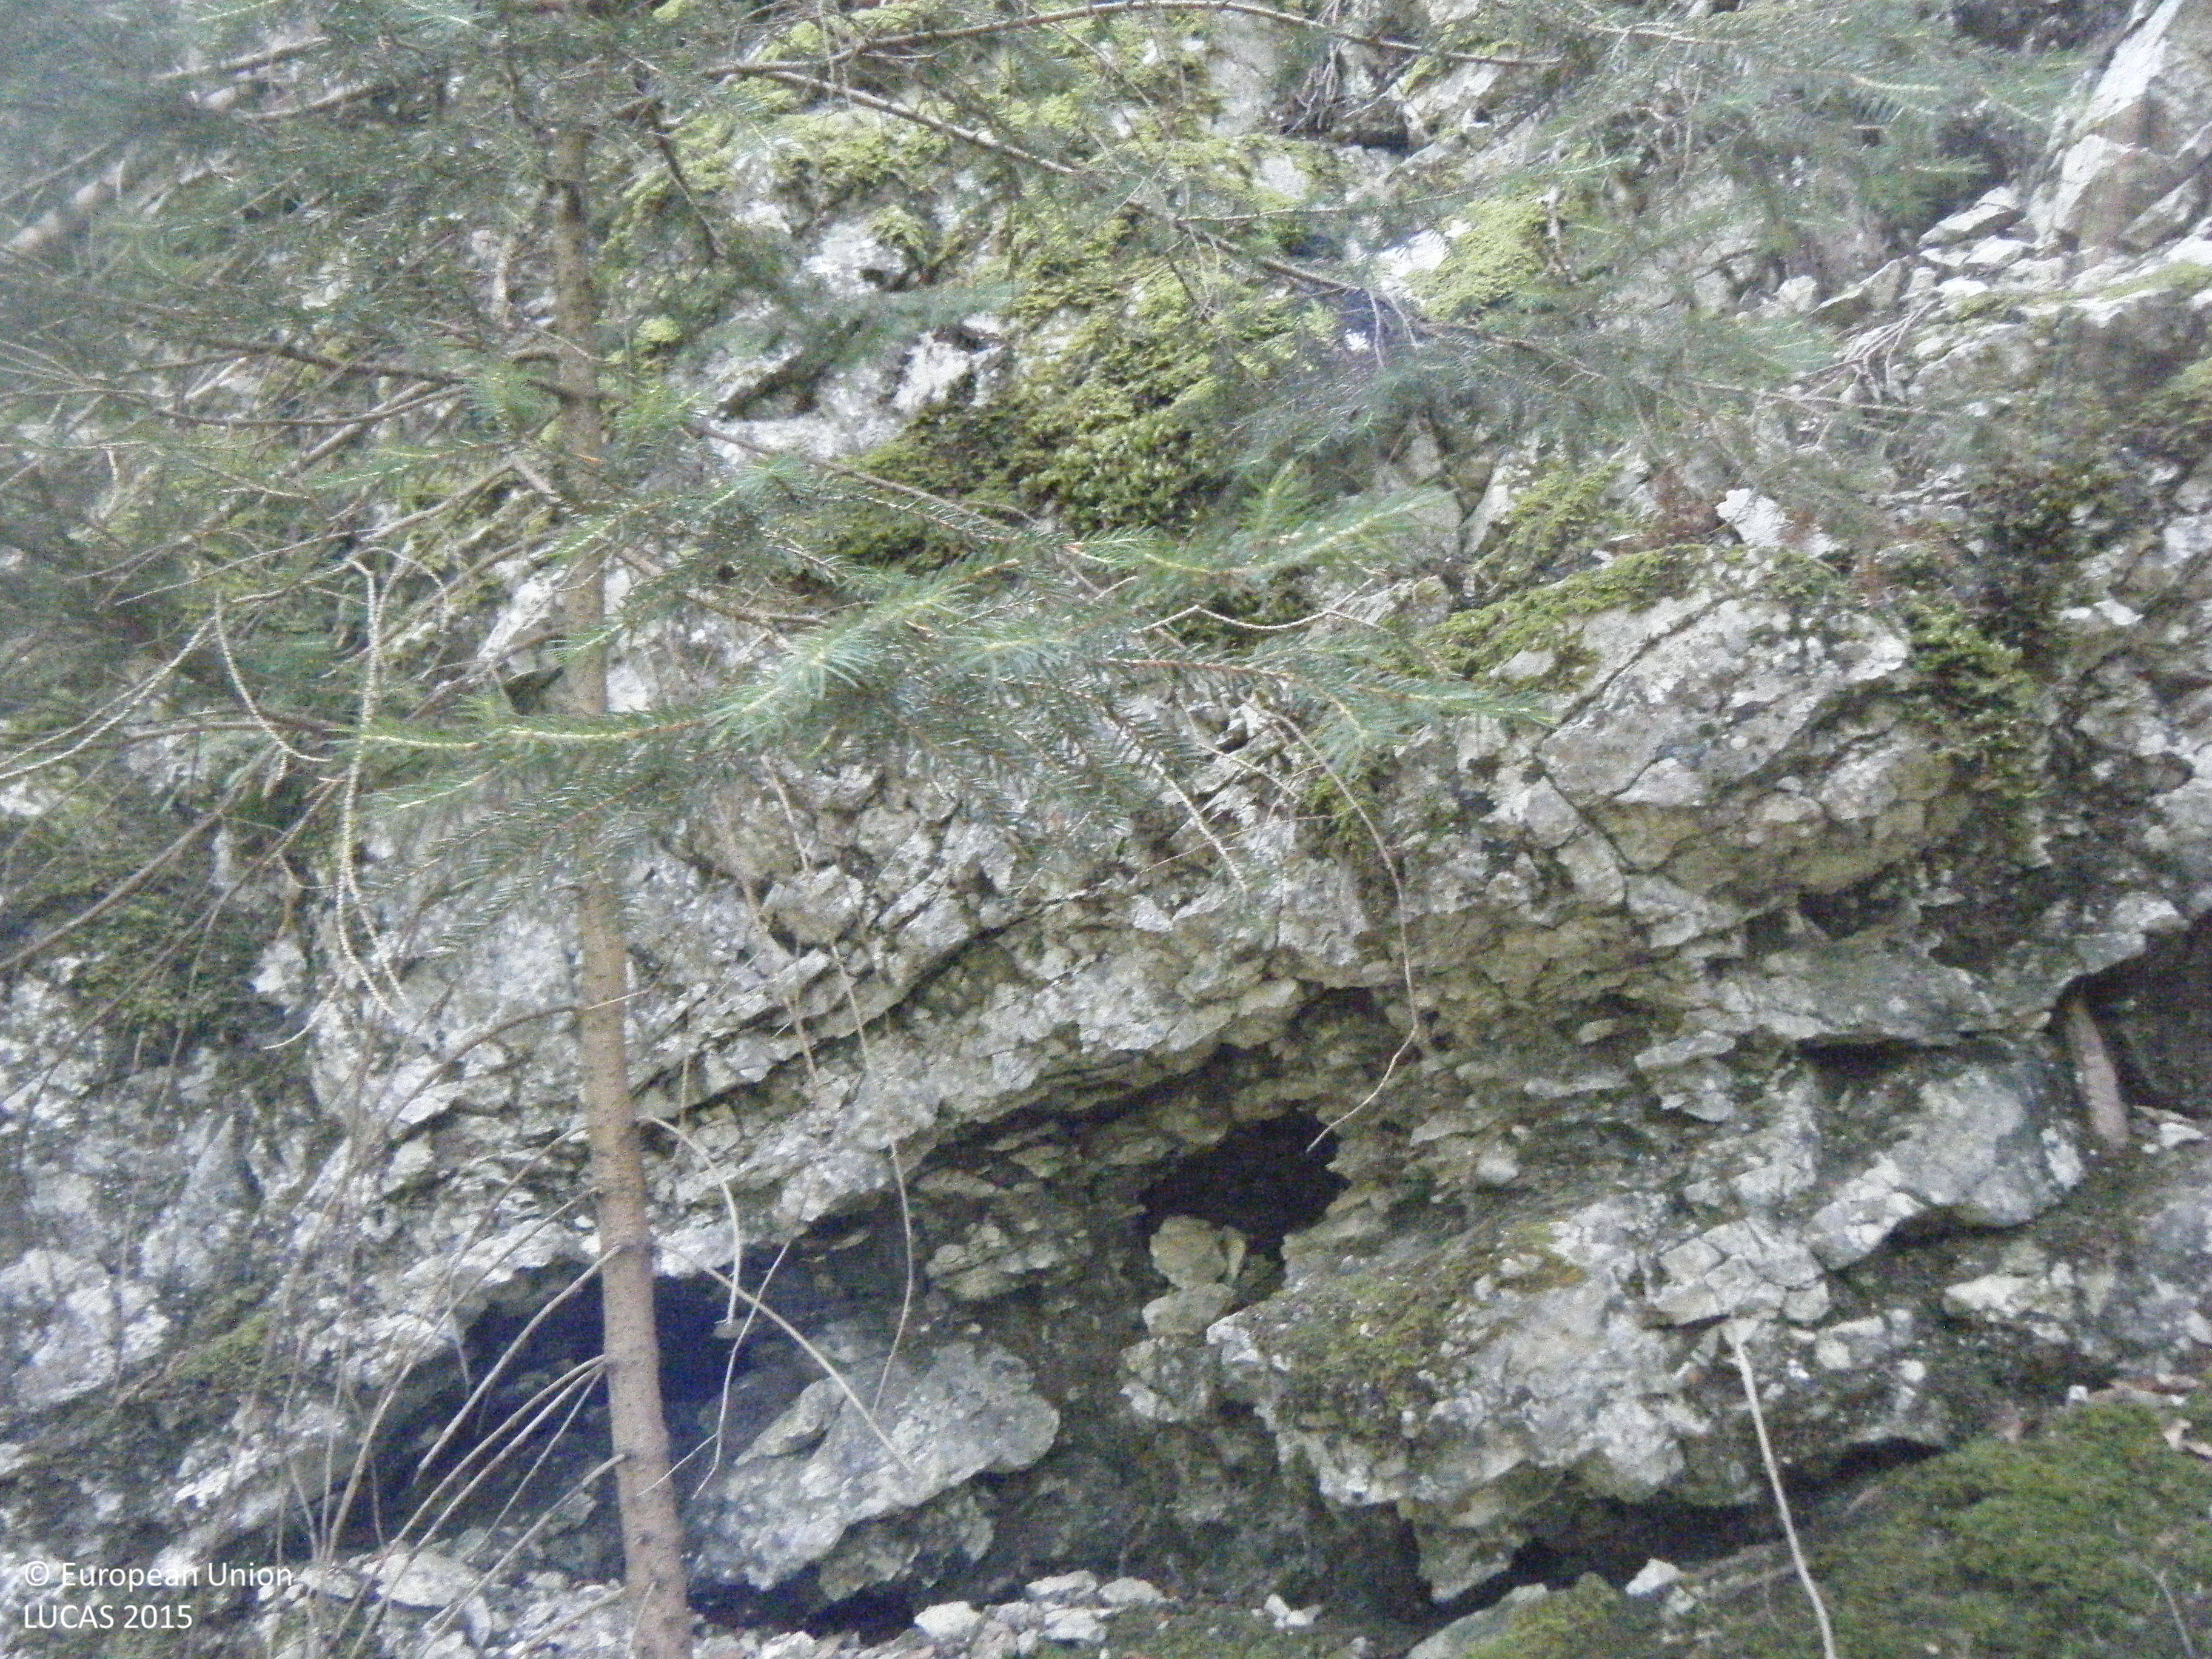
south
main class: Woodland
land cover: Spruce dominated mixed woodland
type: mountainous beech forest
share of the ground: > 75 %
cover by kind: broadleaved forest trees 65 %, coniferous forest trees 25 %, consolidated bare surface 10 %
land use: Forestry
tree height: > 5 m
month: July
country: AT
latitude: 47.7953
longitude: 13.3229
